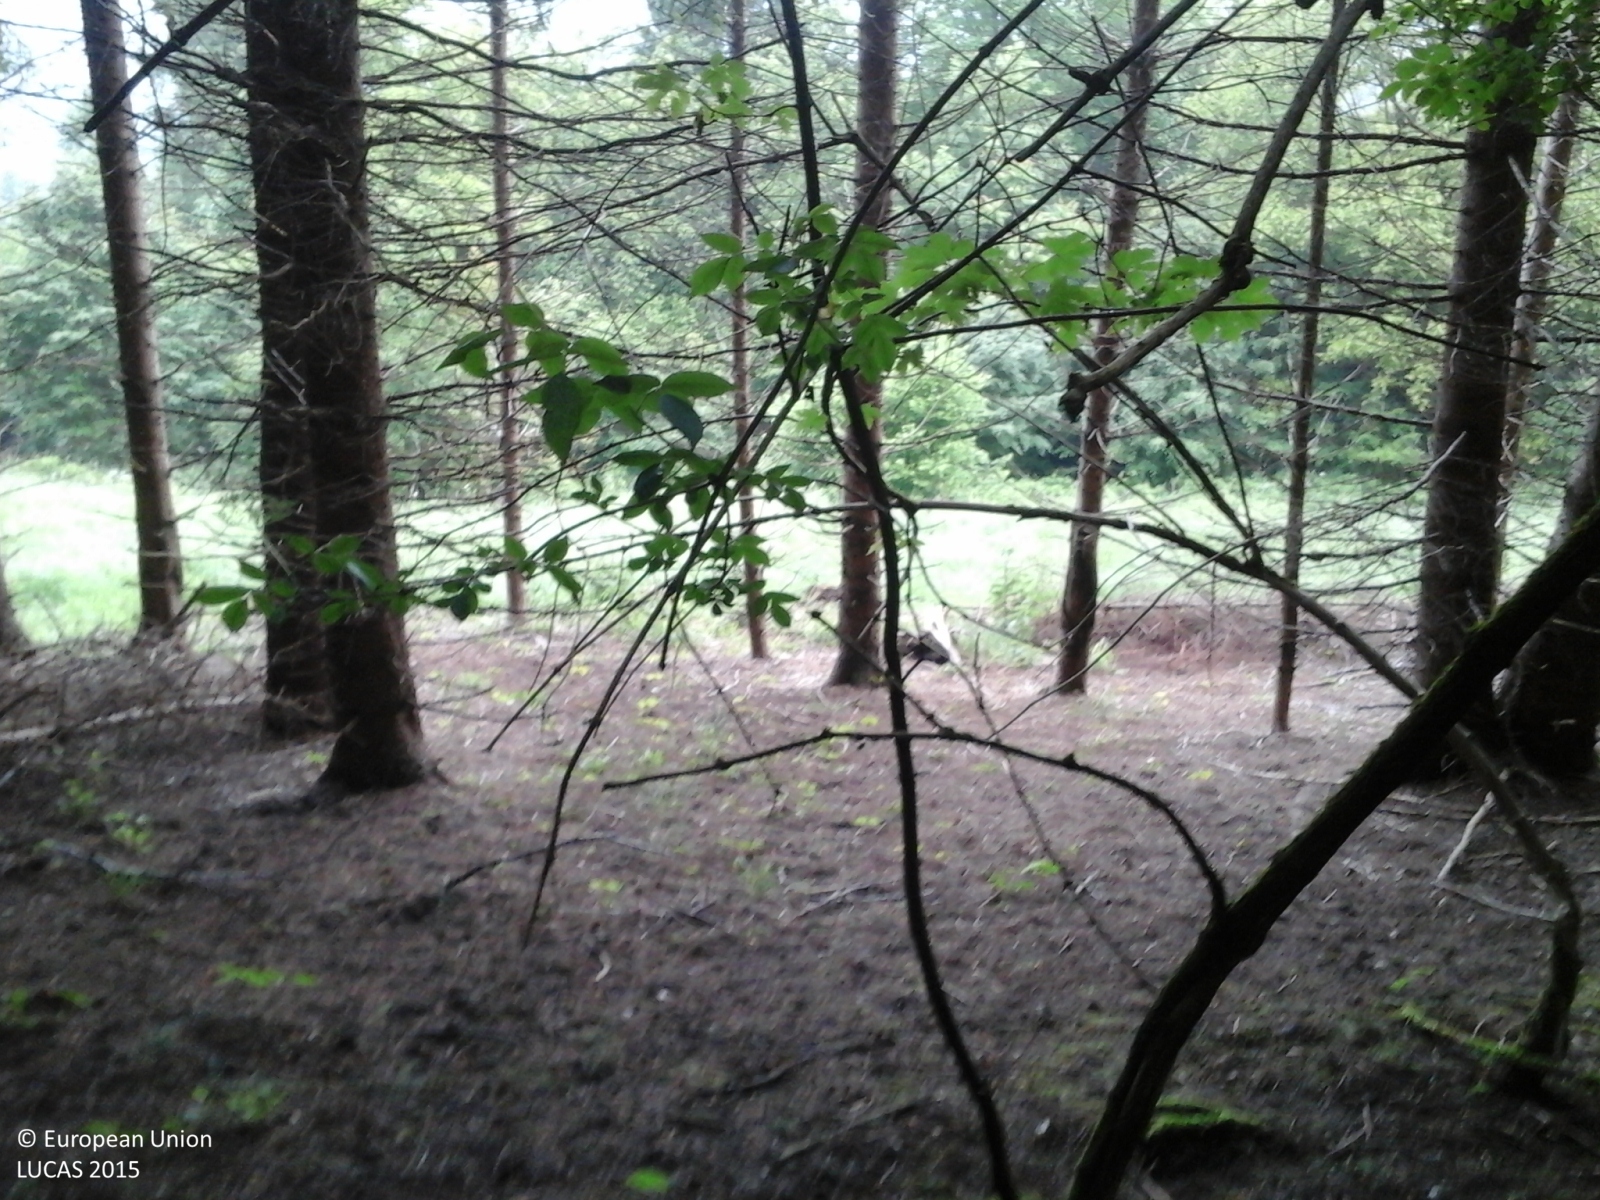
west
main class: Woodland
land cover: Other mixed woodland
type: alpine coniferous forest
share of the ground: > 75 %
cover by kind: broadleaved forest trees 60 %, coniferous forest trees 40 %
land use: Forestry
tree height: > 5 m
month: May
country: IT
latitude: 46.0504
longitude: 11.6391
